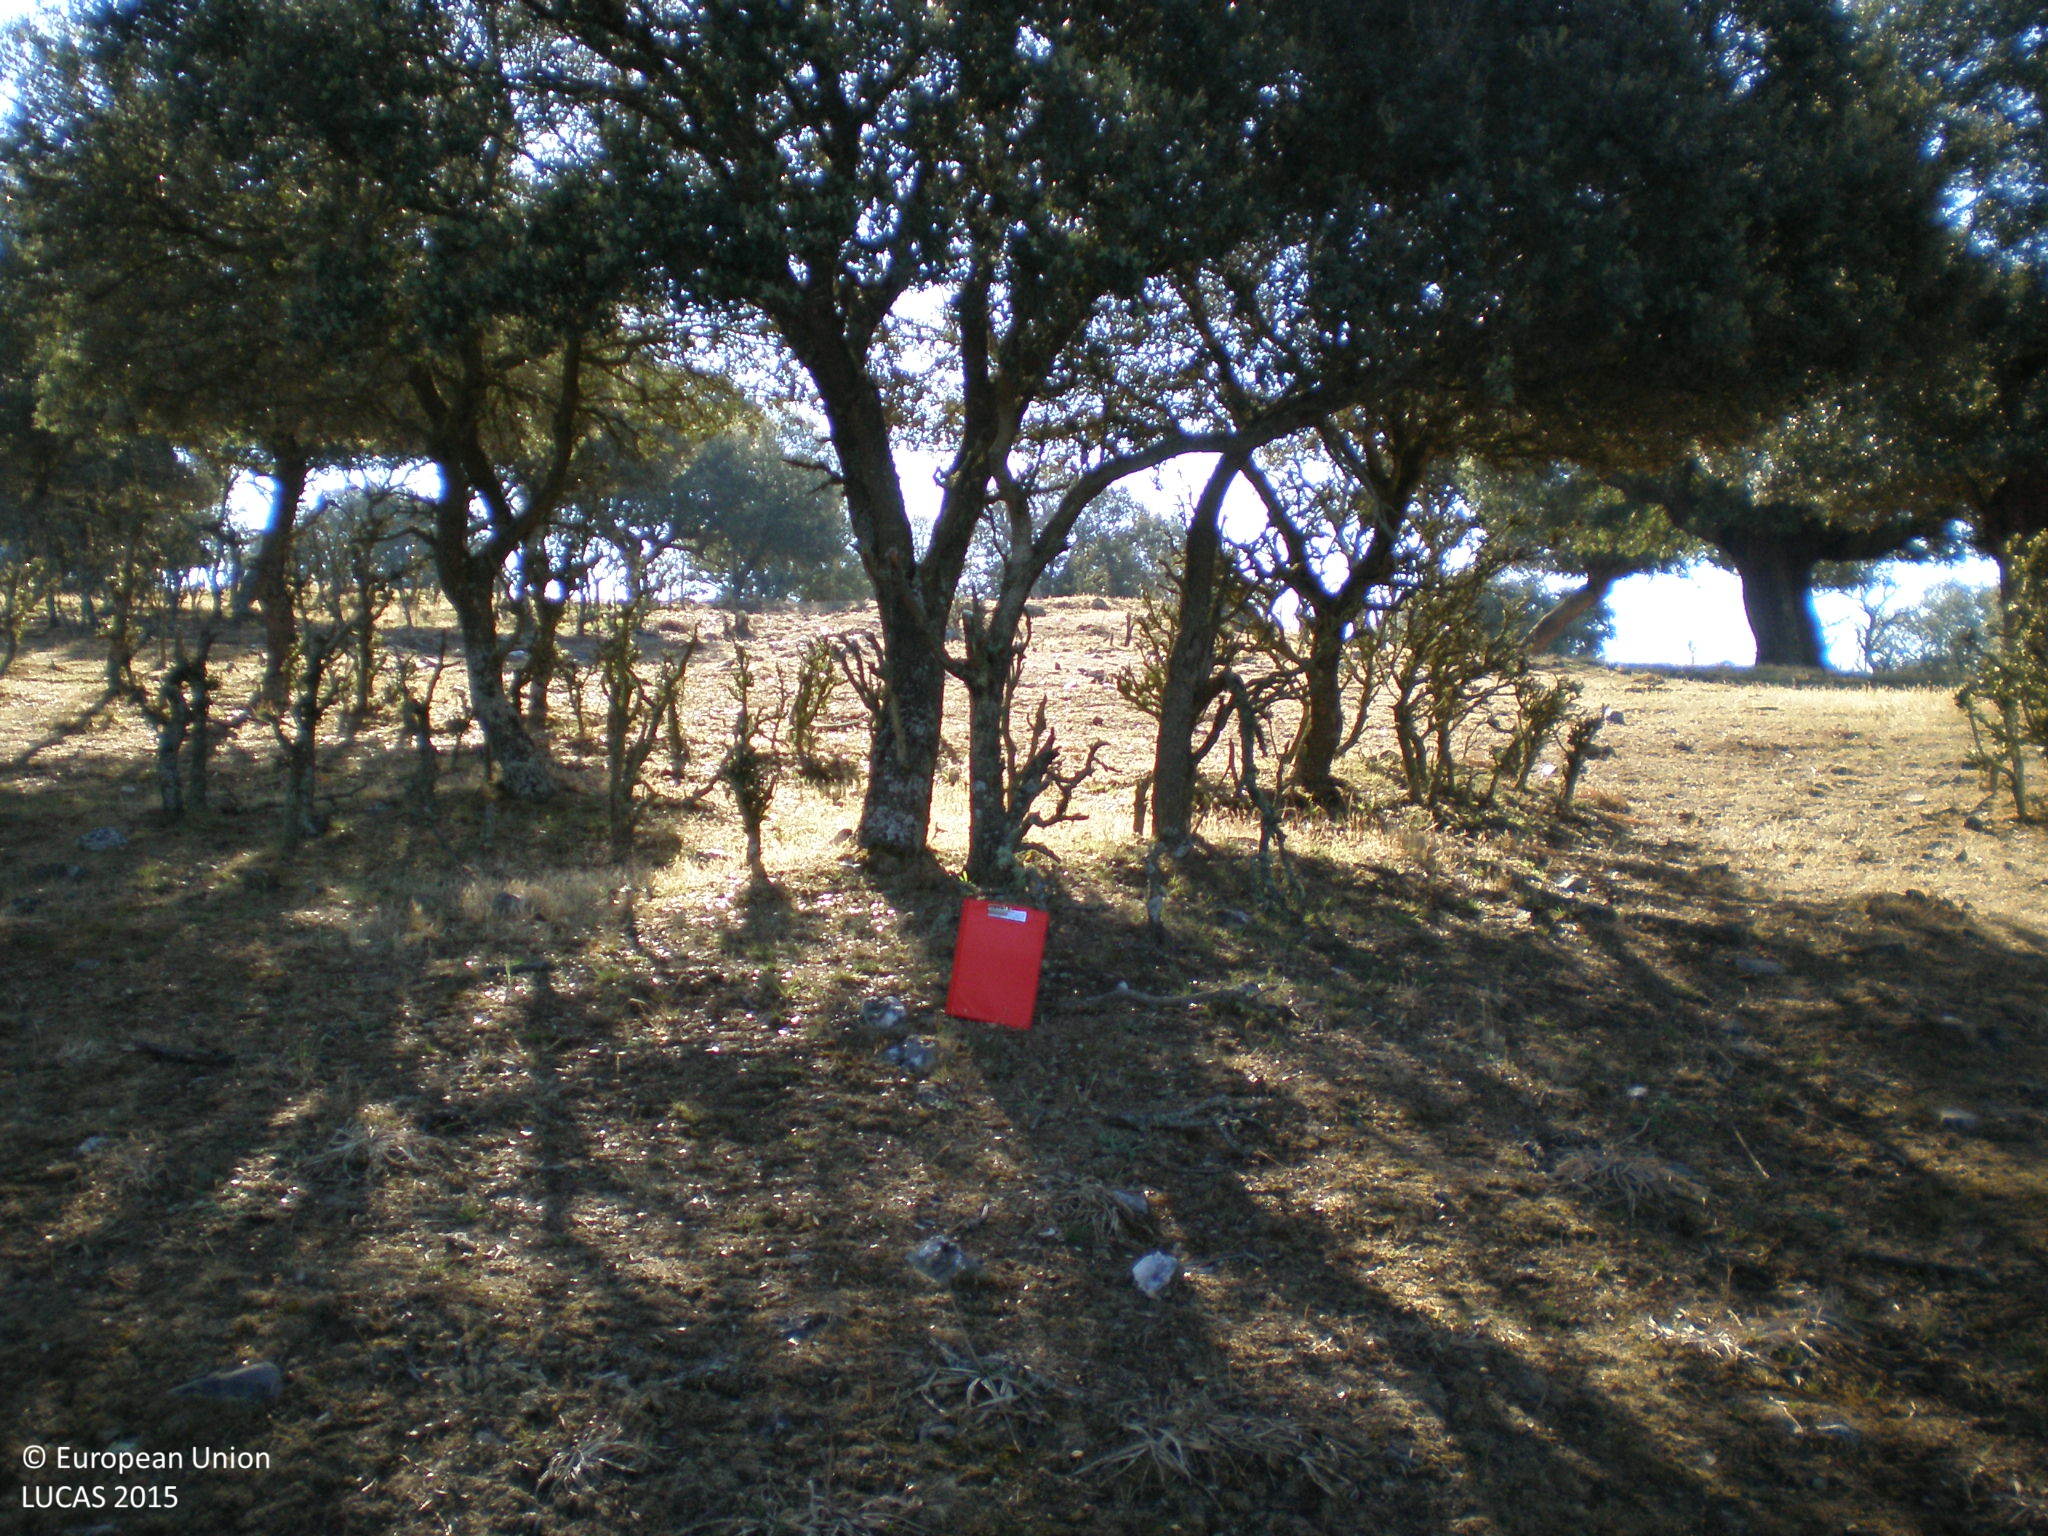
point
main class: Woodland
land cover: Broadleaved woodland
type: broadleaved evergreen forest
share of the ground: 25 - 50 %
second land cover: Grassland without tree/shrub cover
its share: 50 - 75 %
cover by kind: herbaceous plants 55 %, broadleaved forest trees 45 %
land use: Forestry
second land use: Agriculture (excluding fallow land and kitchen gardens)
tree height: > 5 m
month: June
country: ES
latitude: 40.8339
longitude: -5.6939
